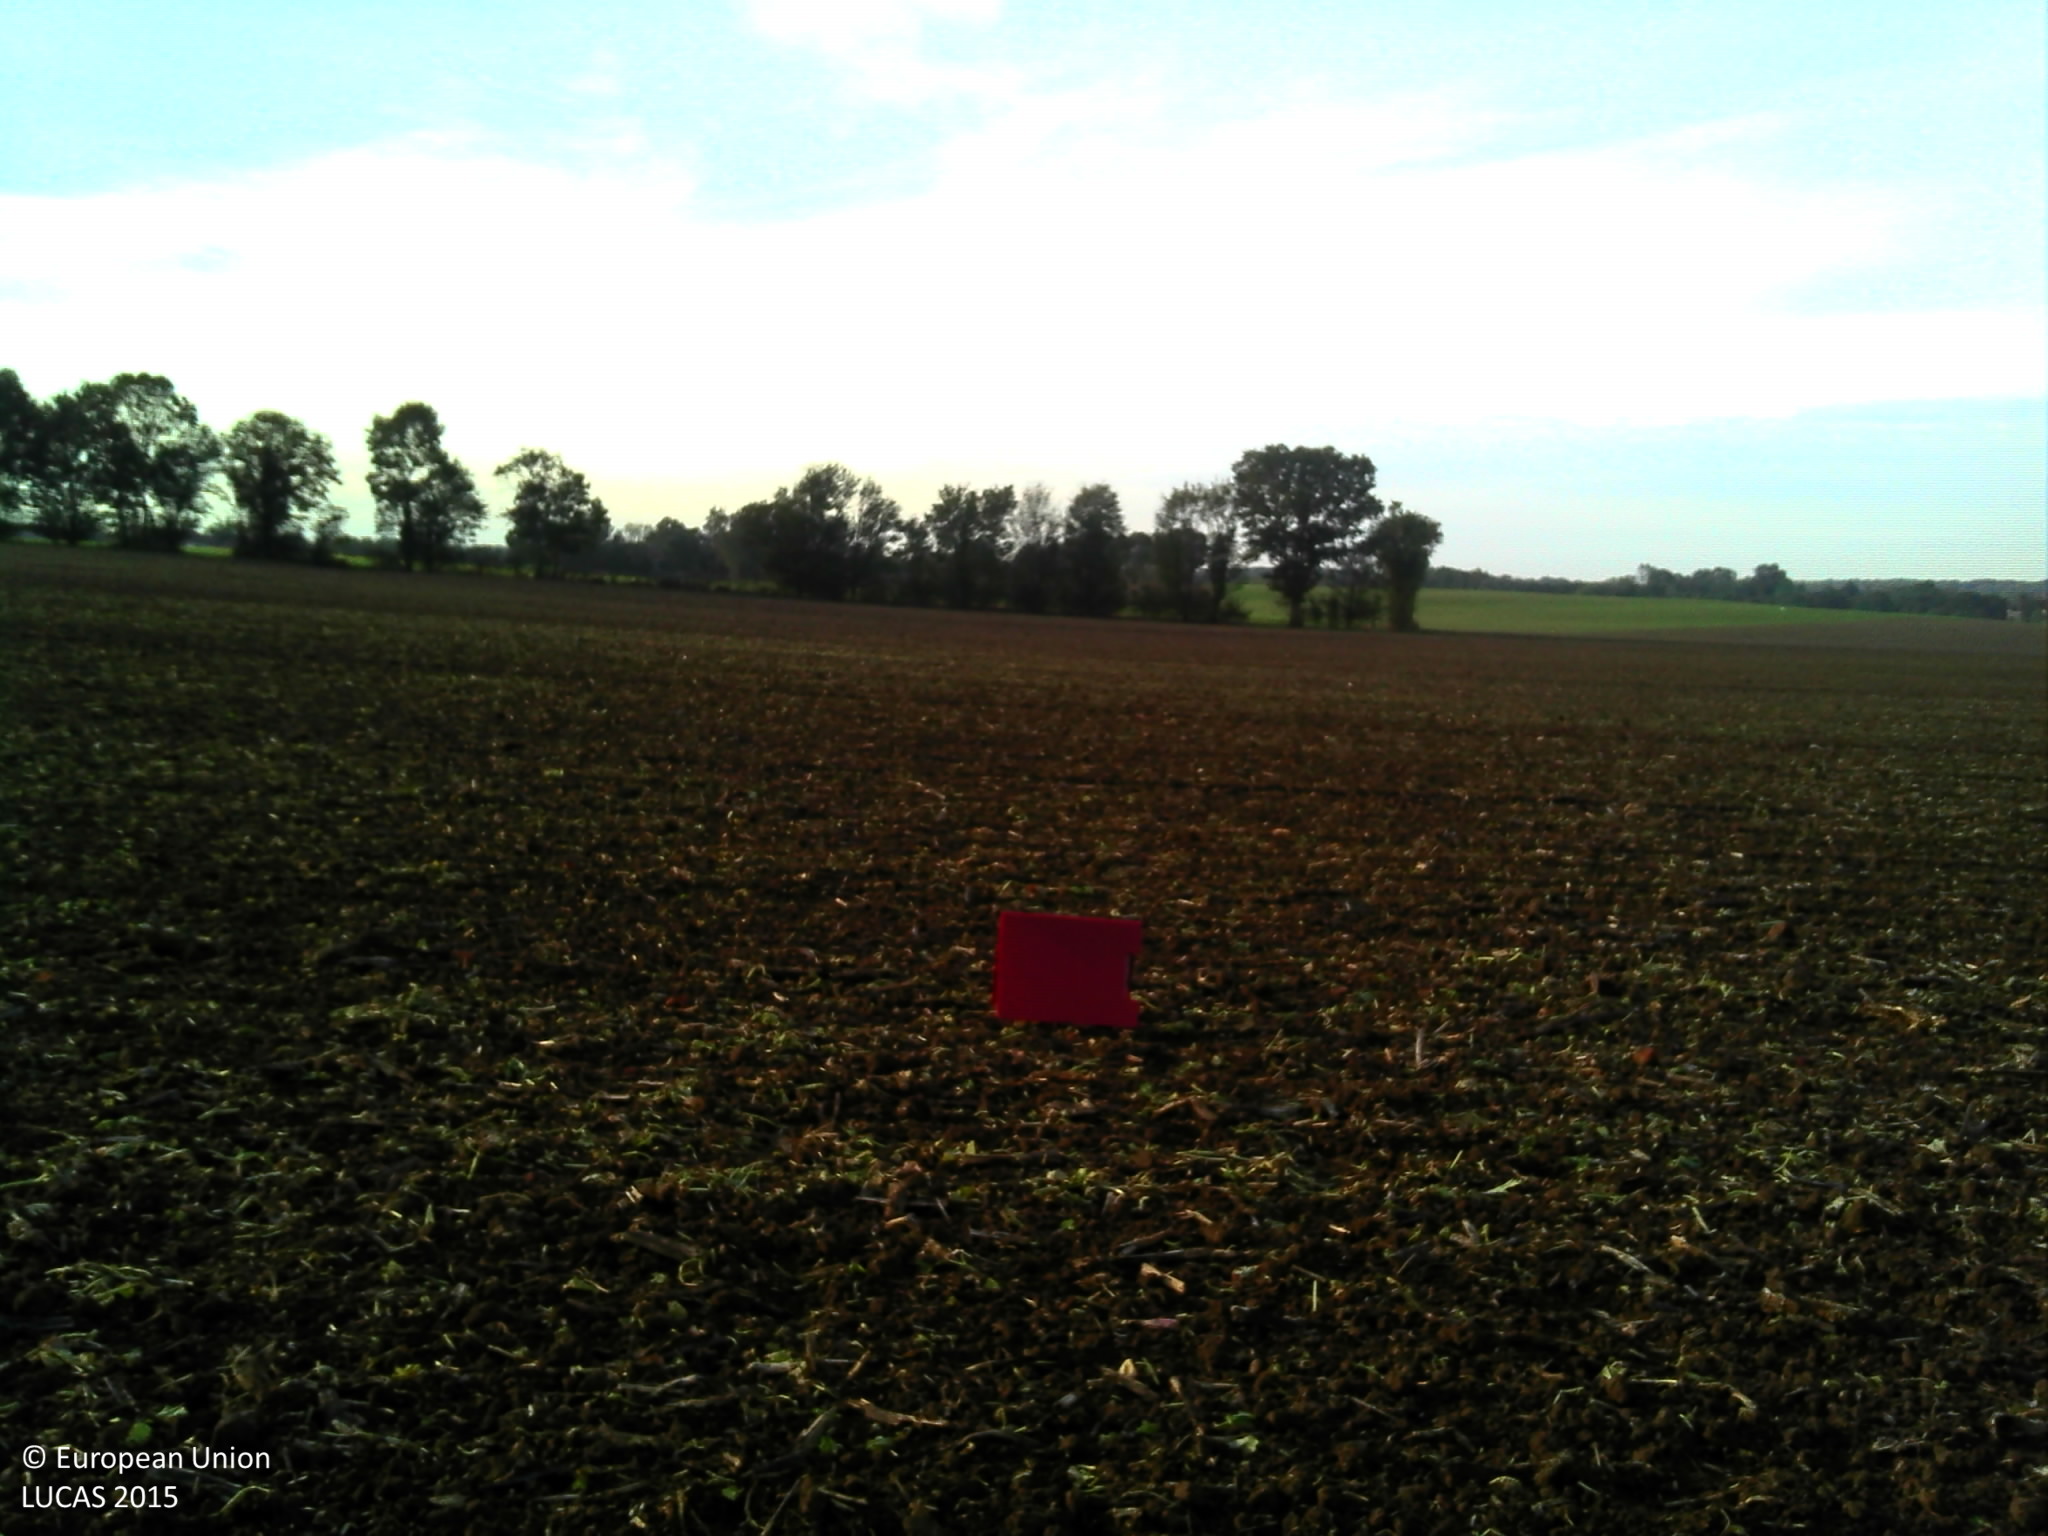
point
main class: Cropland
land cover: Sunflower
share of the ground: > 75 %
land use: Agriculture (excluding fallow land and kitchen gardens)
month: October
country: FR
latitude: 46.3989
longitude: 5.0470
